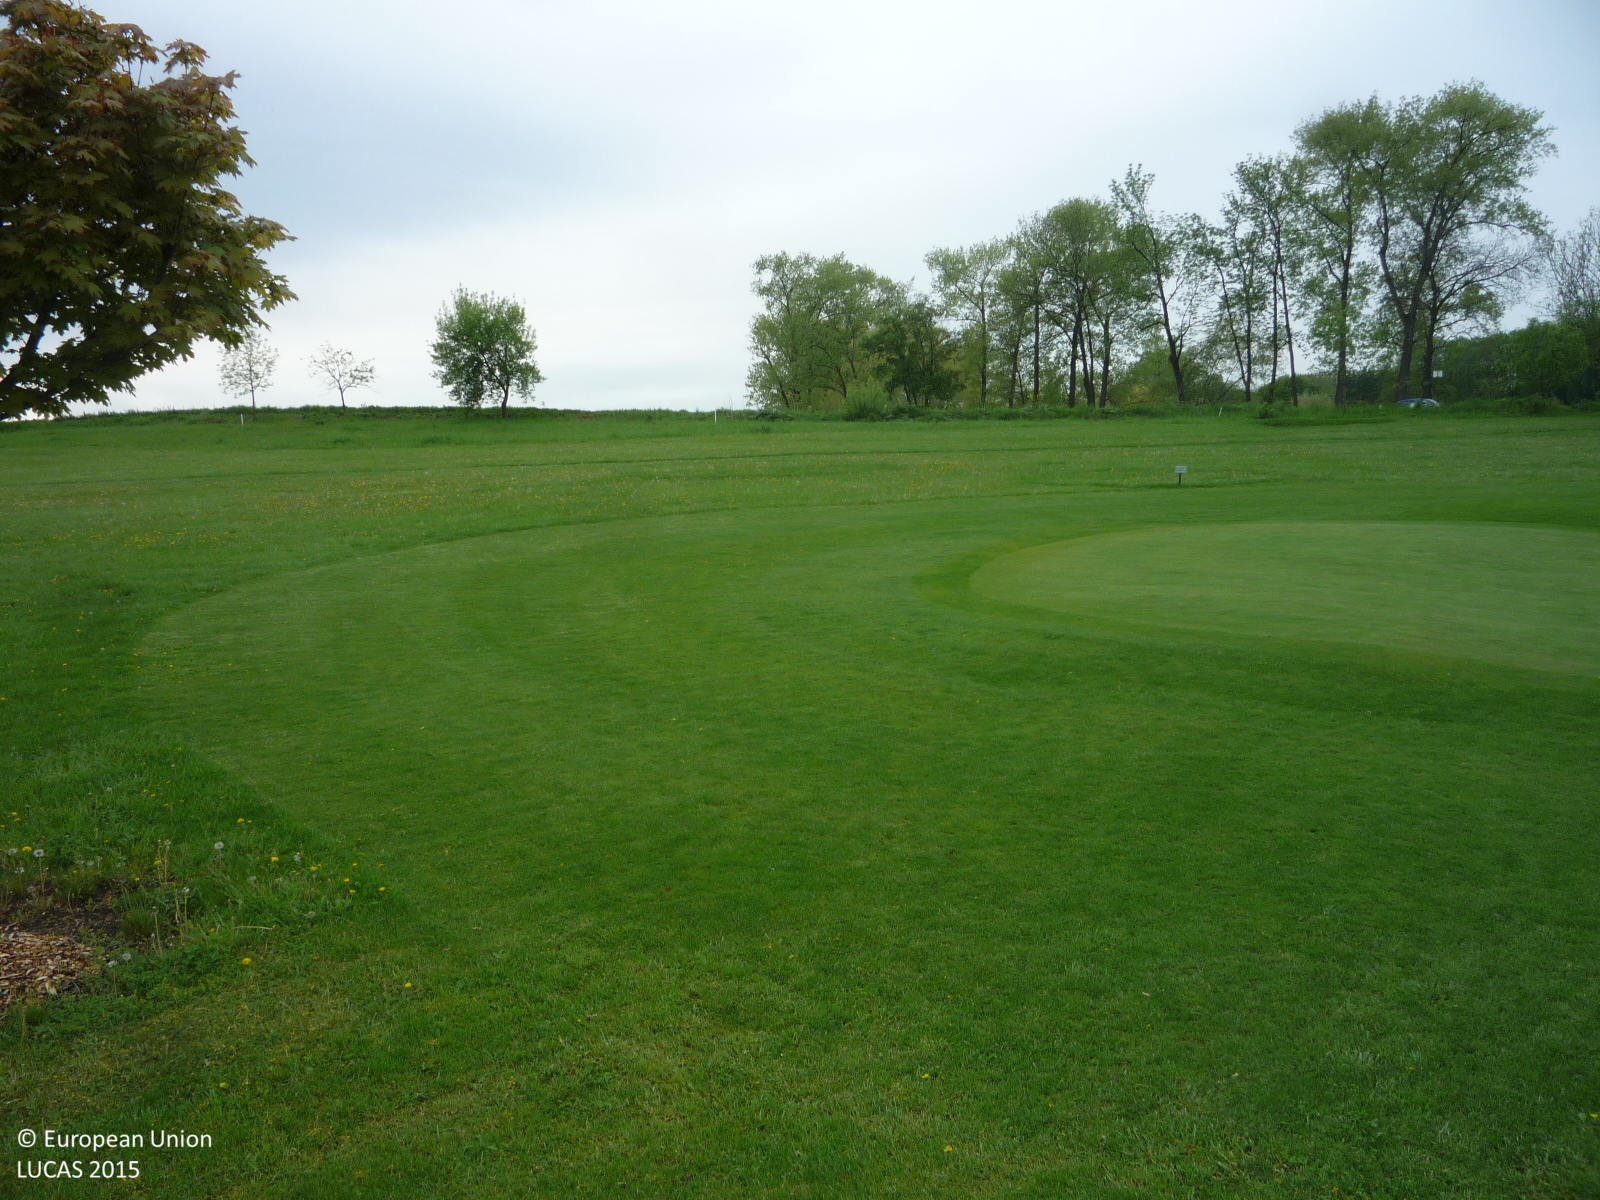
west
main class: Grassland
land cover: Grassland without tree/shrub cover
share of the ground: > 75 %
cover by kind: herbaceous plants 95 %, consolidated bare surface 5 %
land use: Sport
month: May
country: CZ
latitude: 50.2226
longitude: 14.4728
